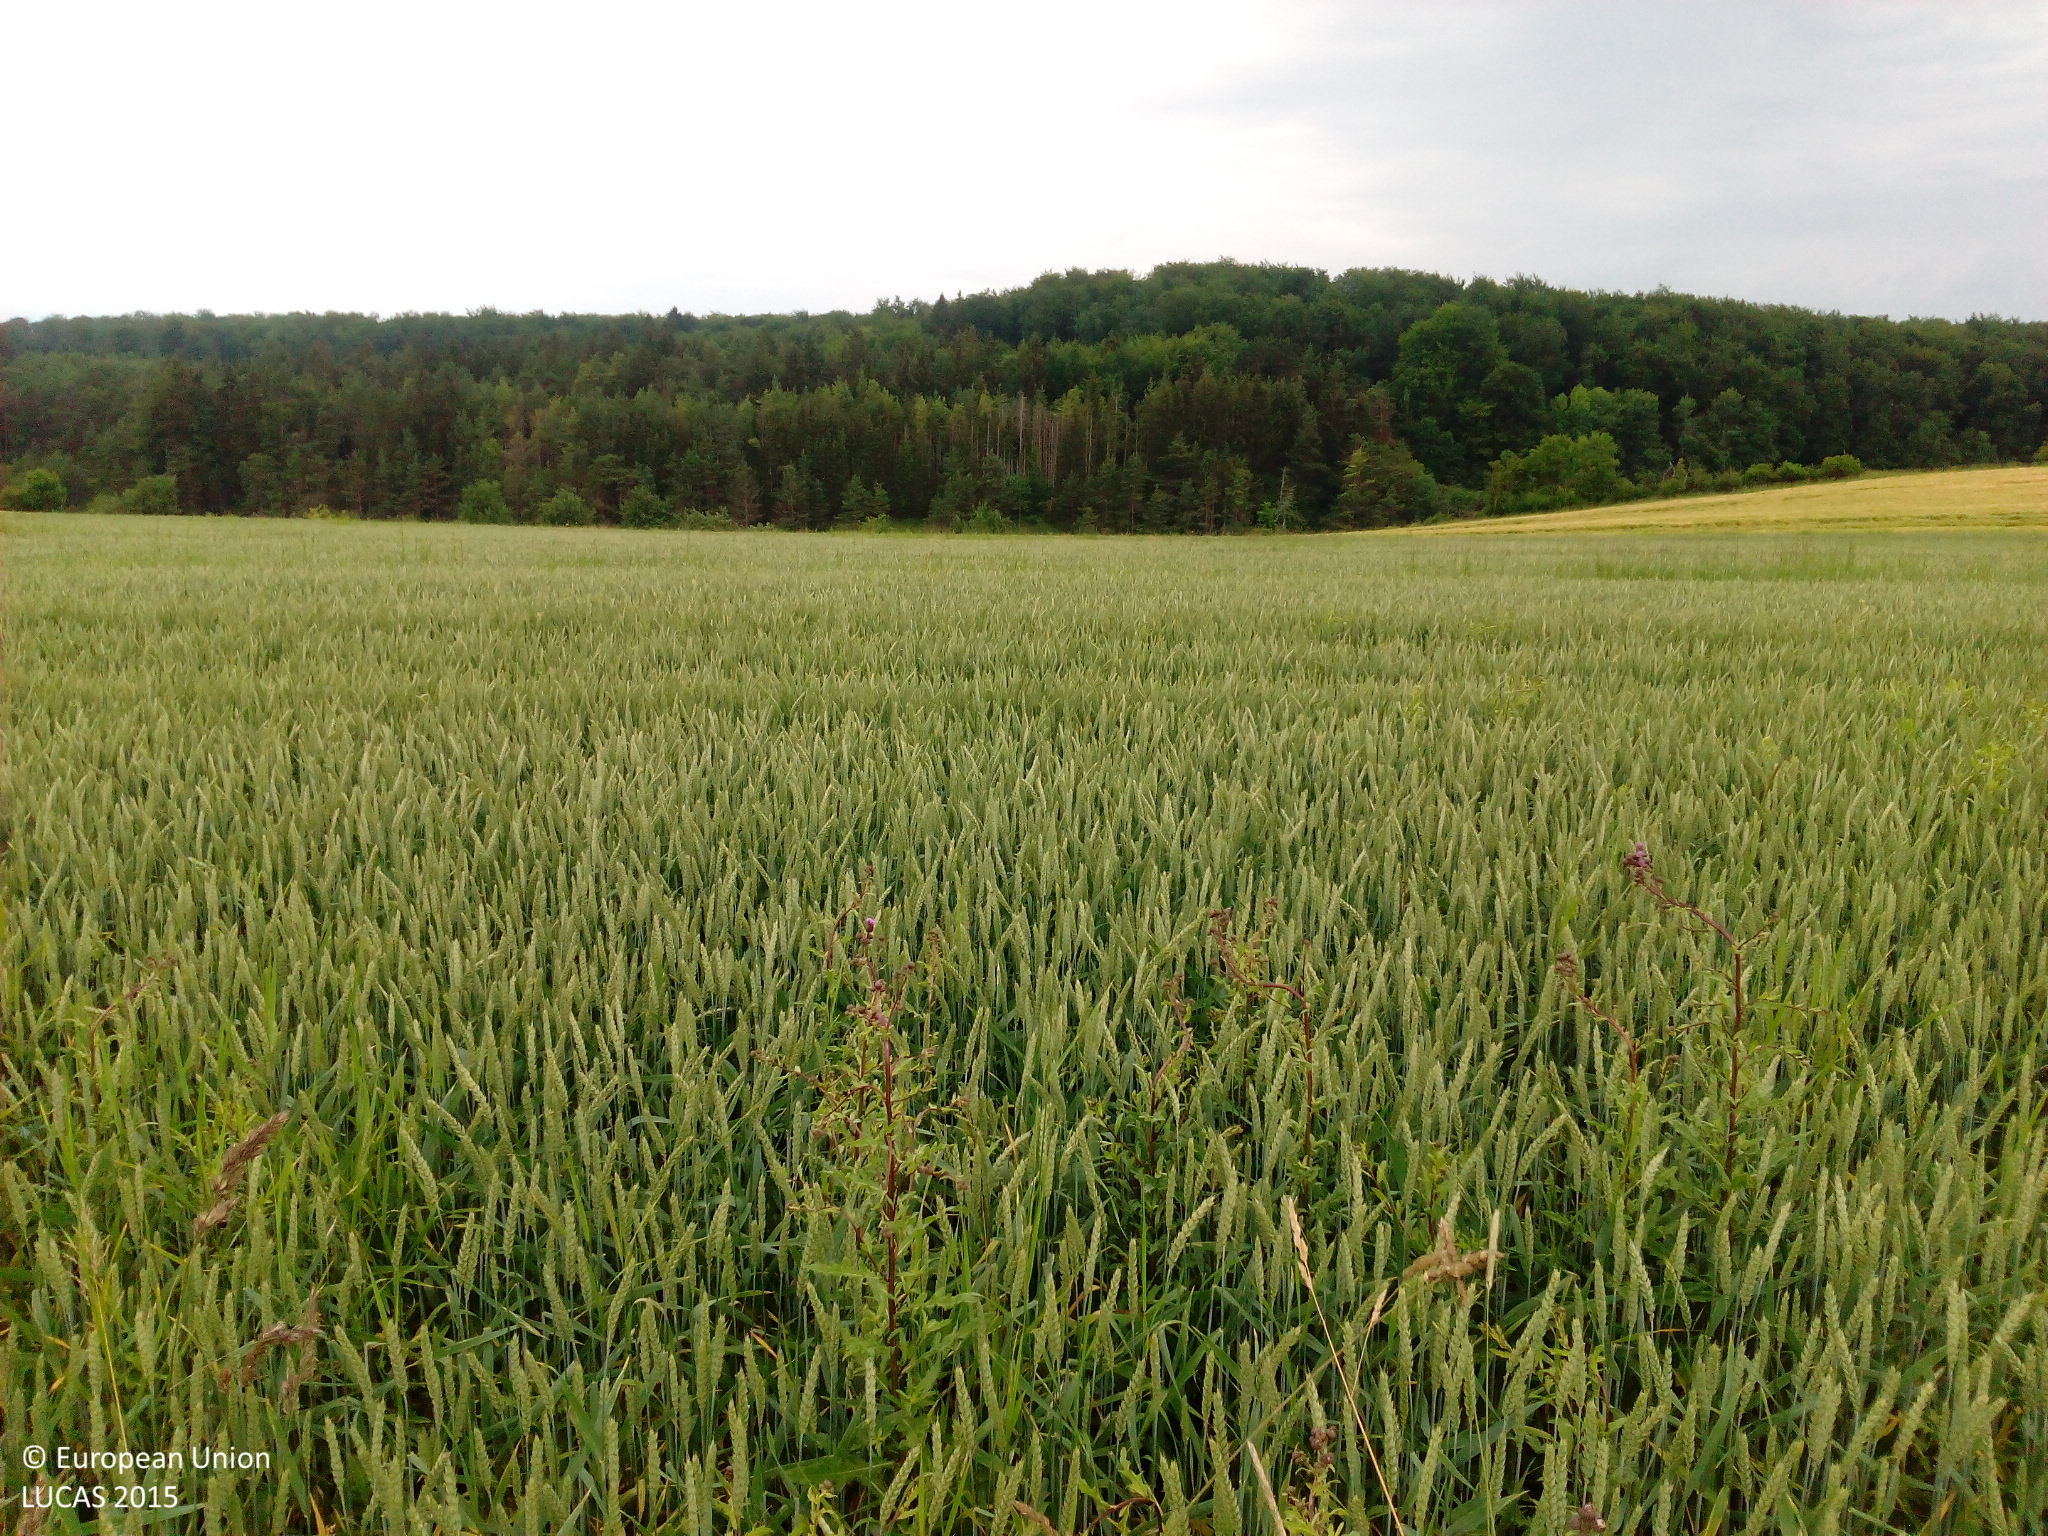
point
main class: Cropland
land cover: Common wheat
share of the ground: > 75 %
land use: Agriculture (excluding fallow land and kitchen gardens)
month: June
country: DE
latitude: 48.3128
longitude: 9.6092
